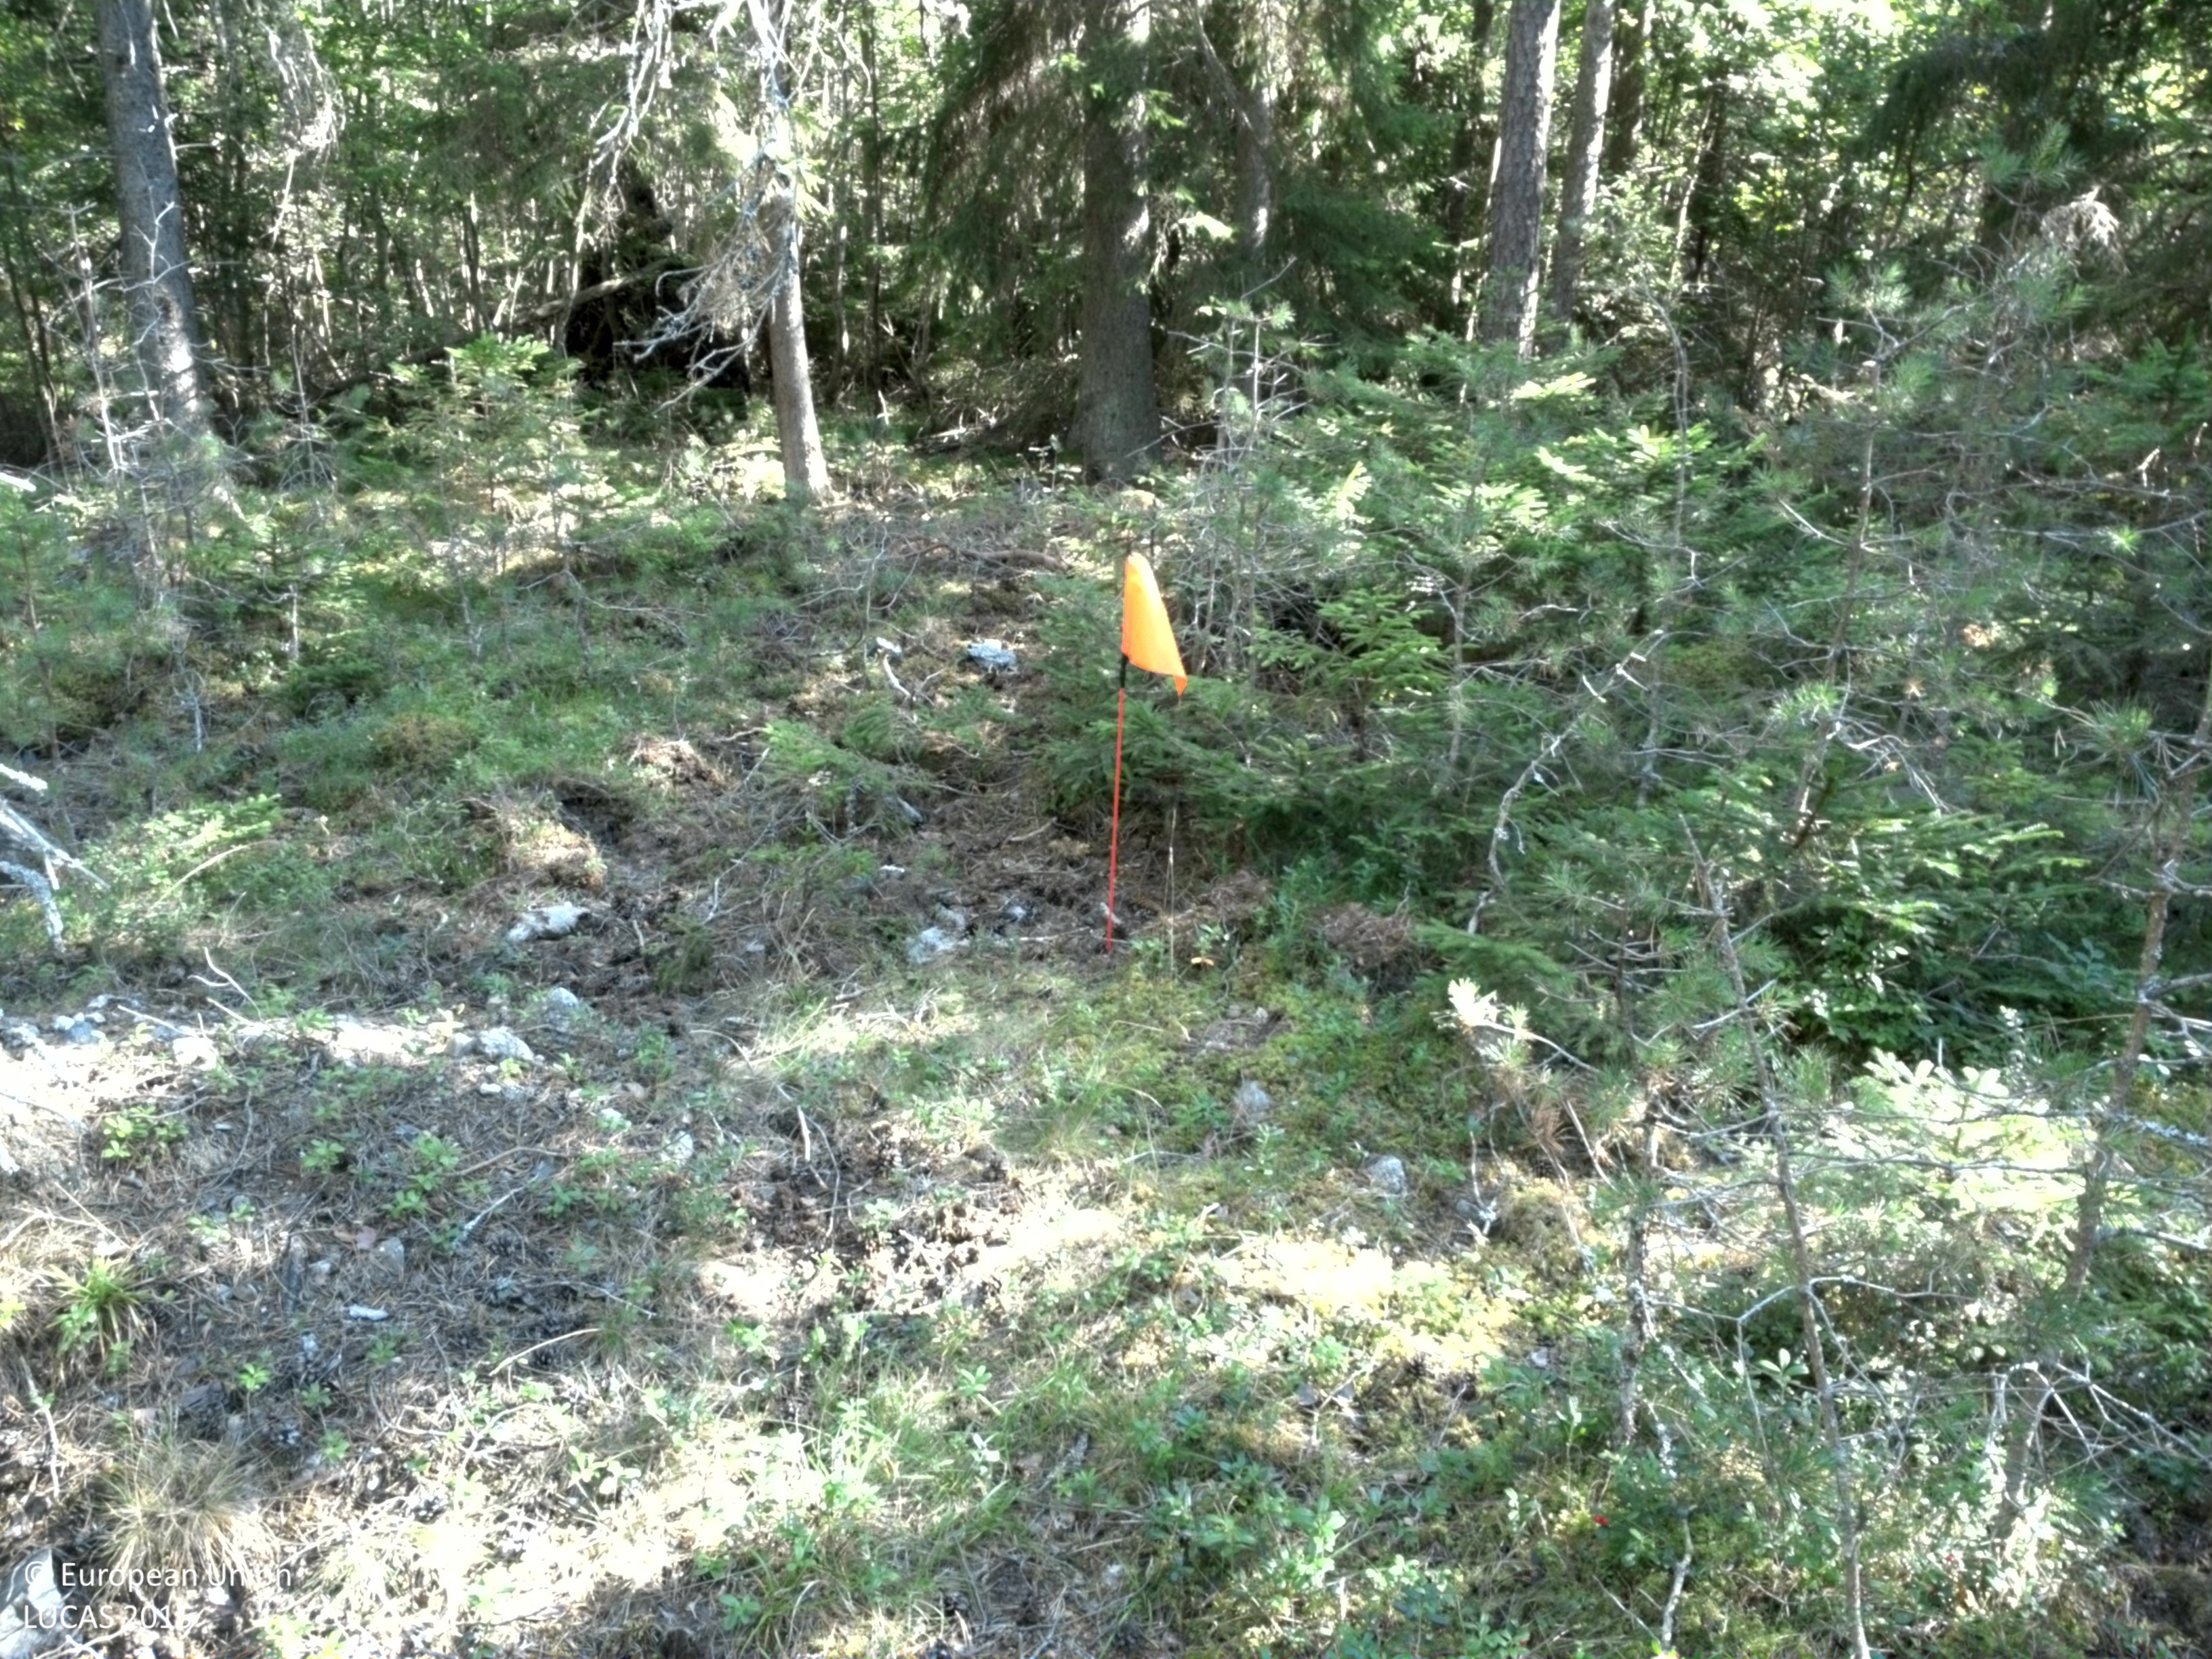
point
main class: Woodland
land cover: Other coniferous woodland
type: boreal forest
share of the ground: > 75 %
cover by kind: coniferous forest trees 85 %, lichens and mosses 15 %
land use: Amenities, museums, leisure
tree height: > 5 m
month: August
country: SE
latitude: 59.6872
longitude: 17.5796
